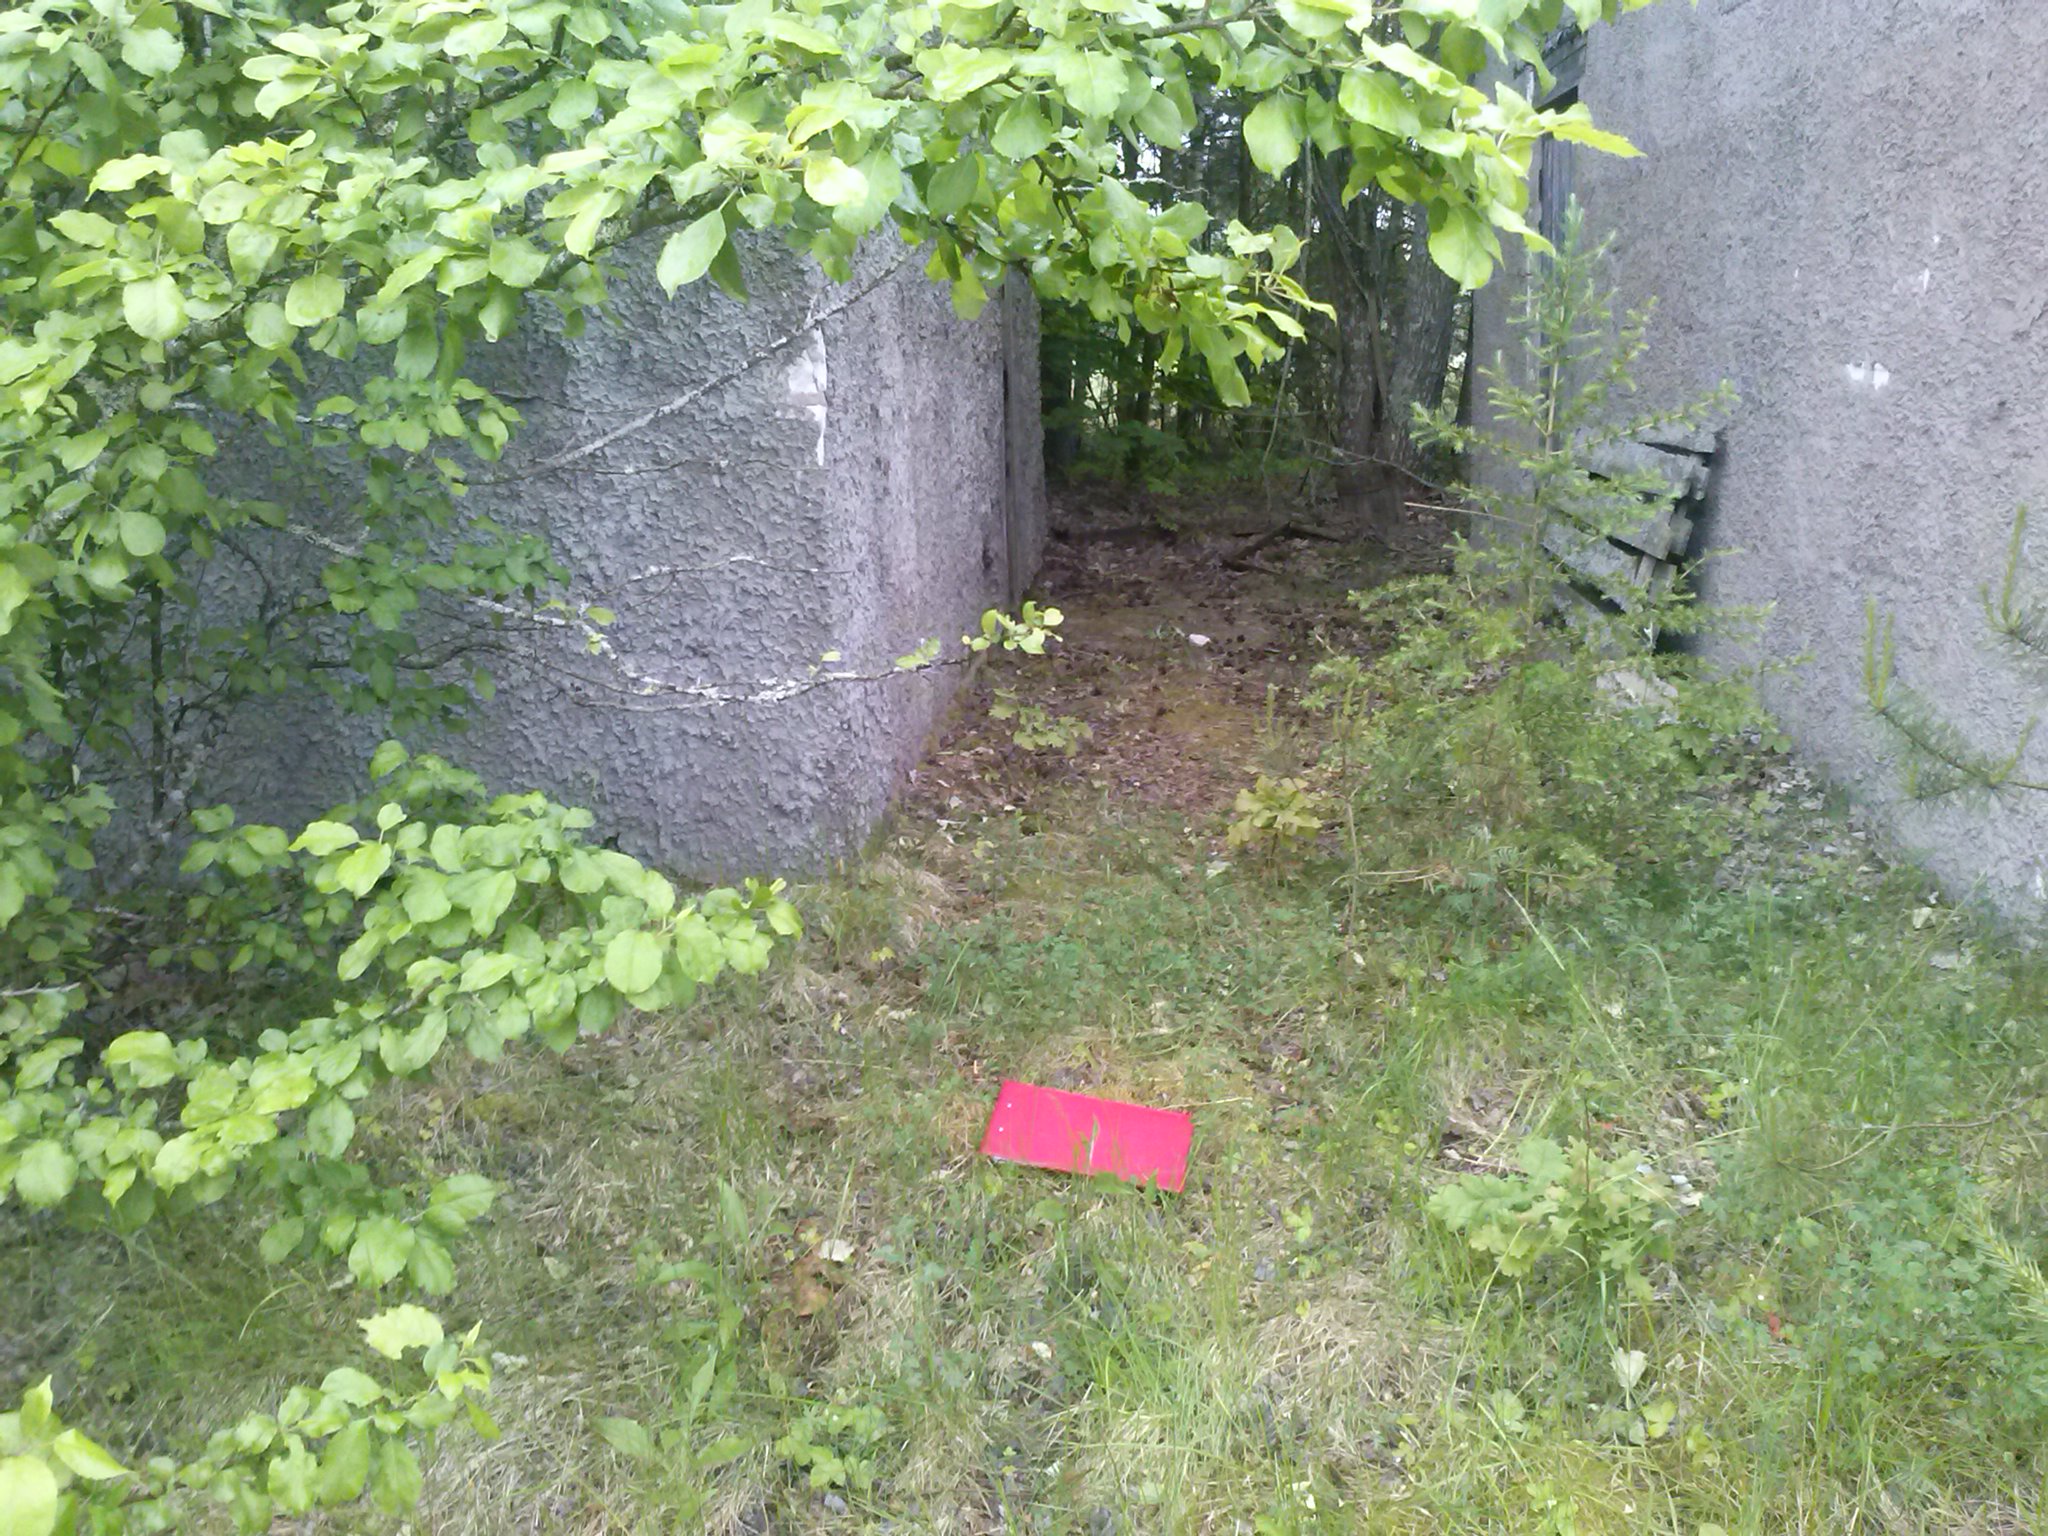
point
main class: Woodland
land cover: Broadleaved woodland
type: non-riverine alder, birch or aspen forest
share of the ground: 50 - 75 %
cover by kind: broadleaved forest trees 50 %, herbaceous plants 40 %, coniferous forest trees 5 %, shrubs 5 %
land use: Abandoned areas
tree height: > 5 m
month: June
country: LV
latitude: 56.9127
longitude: 27.1993
